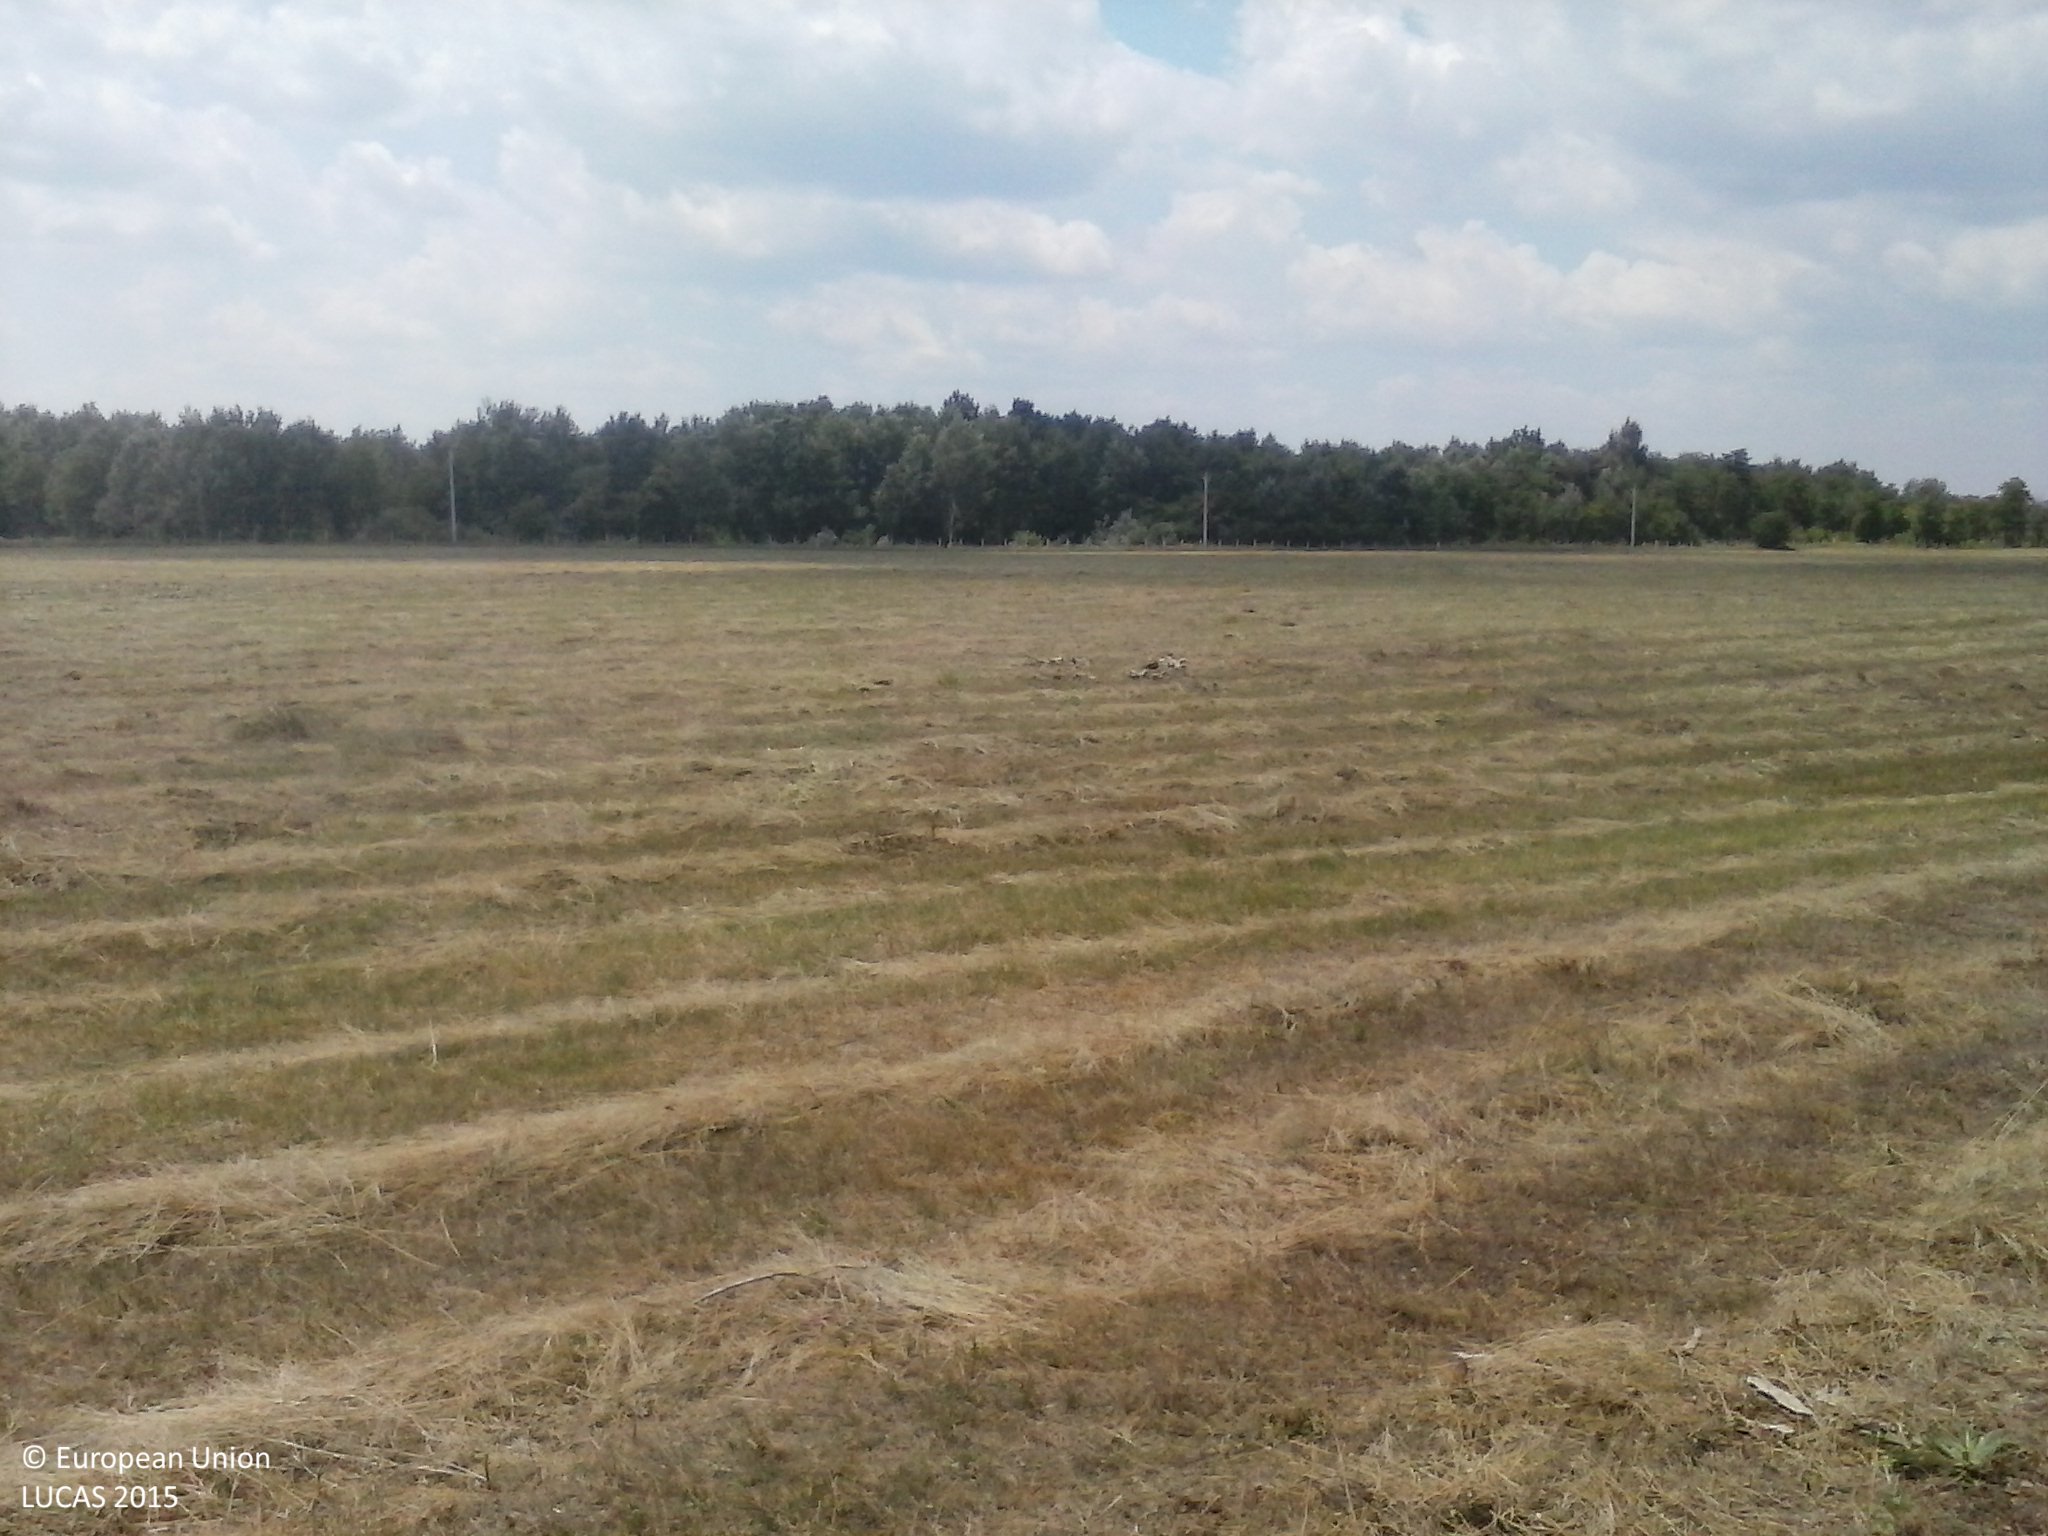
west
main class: Grassland
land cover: Grassland without tree/shrub cover
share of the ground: > 75 %
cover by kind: herbaceous plants 100 %
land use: Agriculture (excluding fallow land and kitchen gardens)
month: July
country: HU
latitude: 46.3587
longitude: 19.5437
